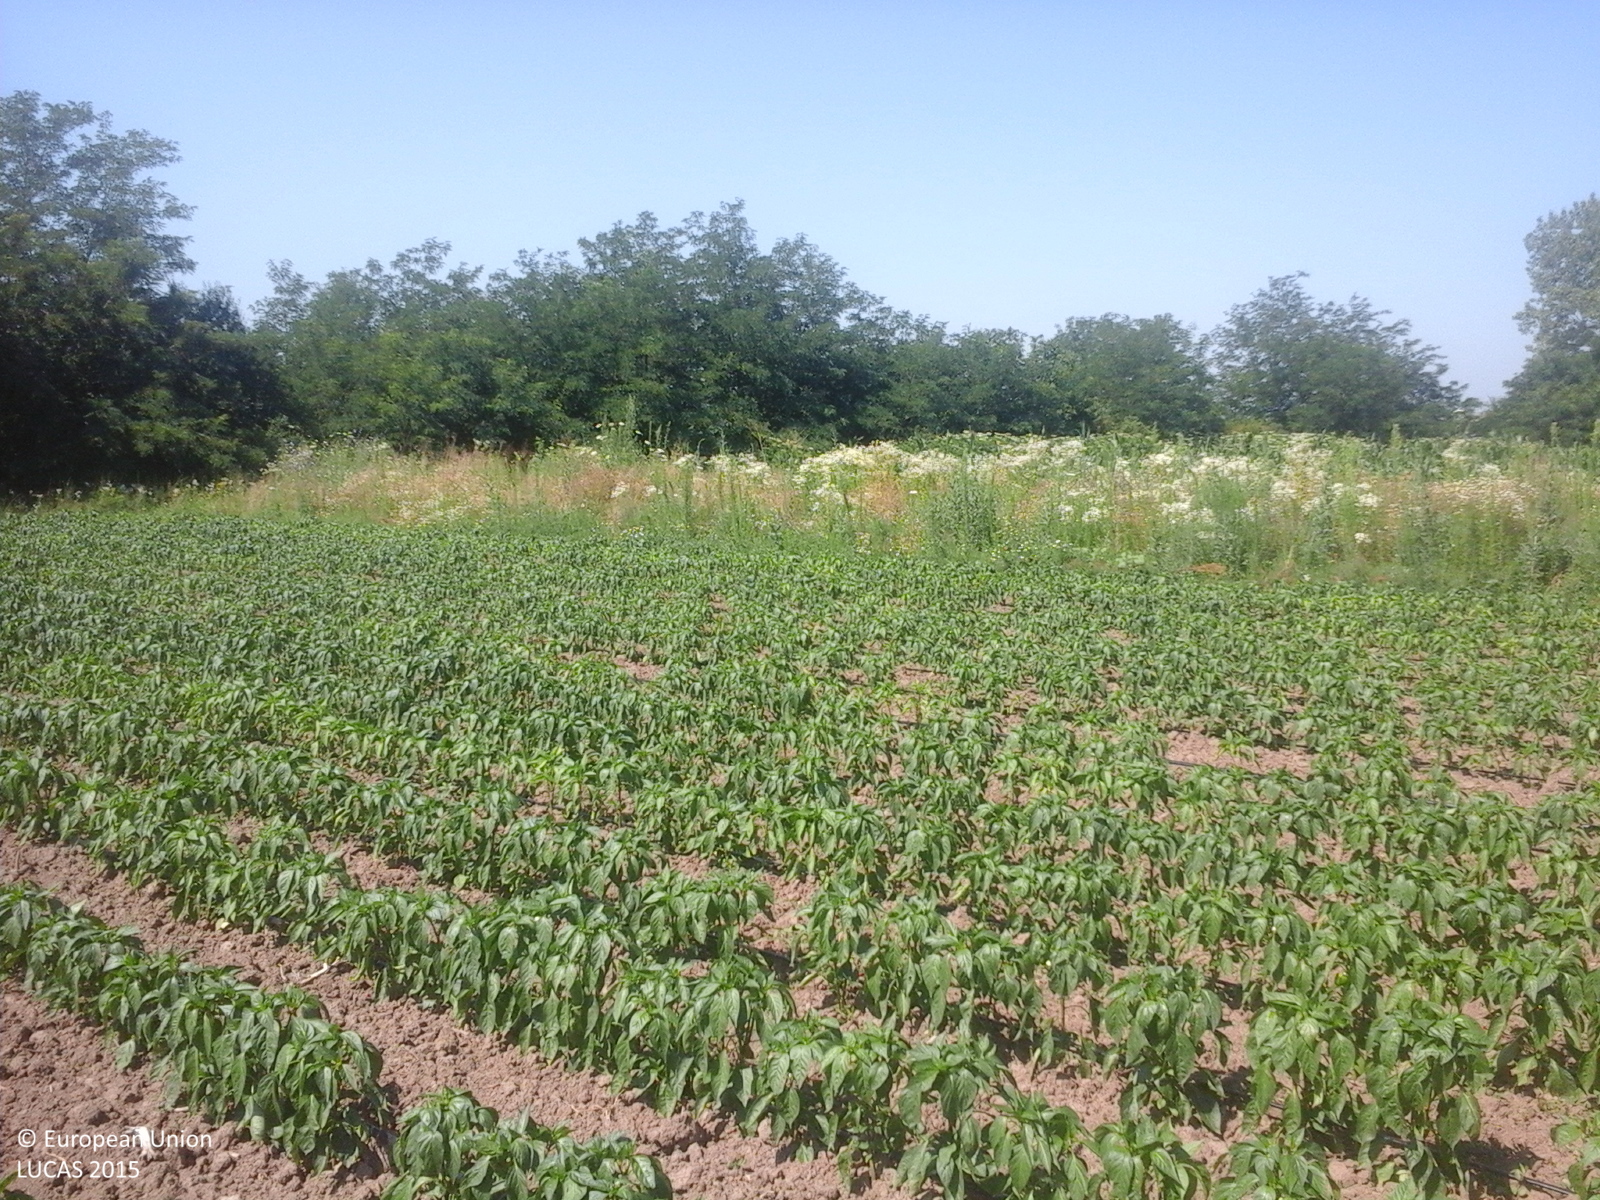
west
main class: Cropland
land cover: Other fresh vegetables
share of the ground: 25 - 50 %
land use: Agriculture (excluding fallow land and kitchen gardens)
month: July
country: RO
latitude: 44.5320
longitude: 24.2486
